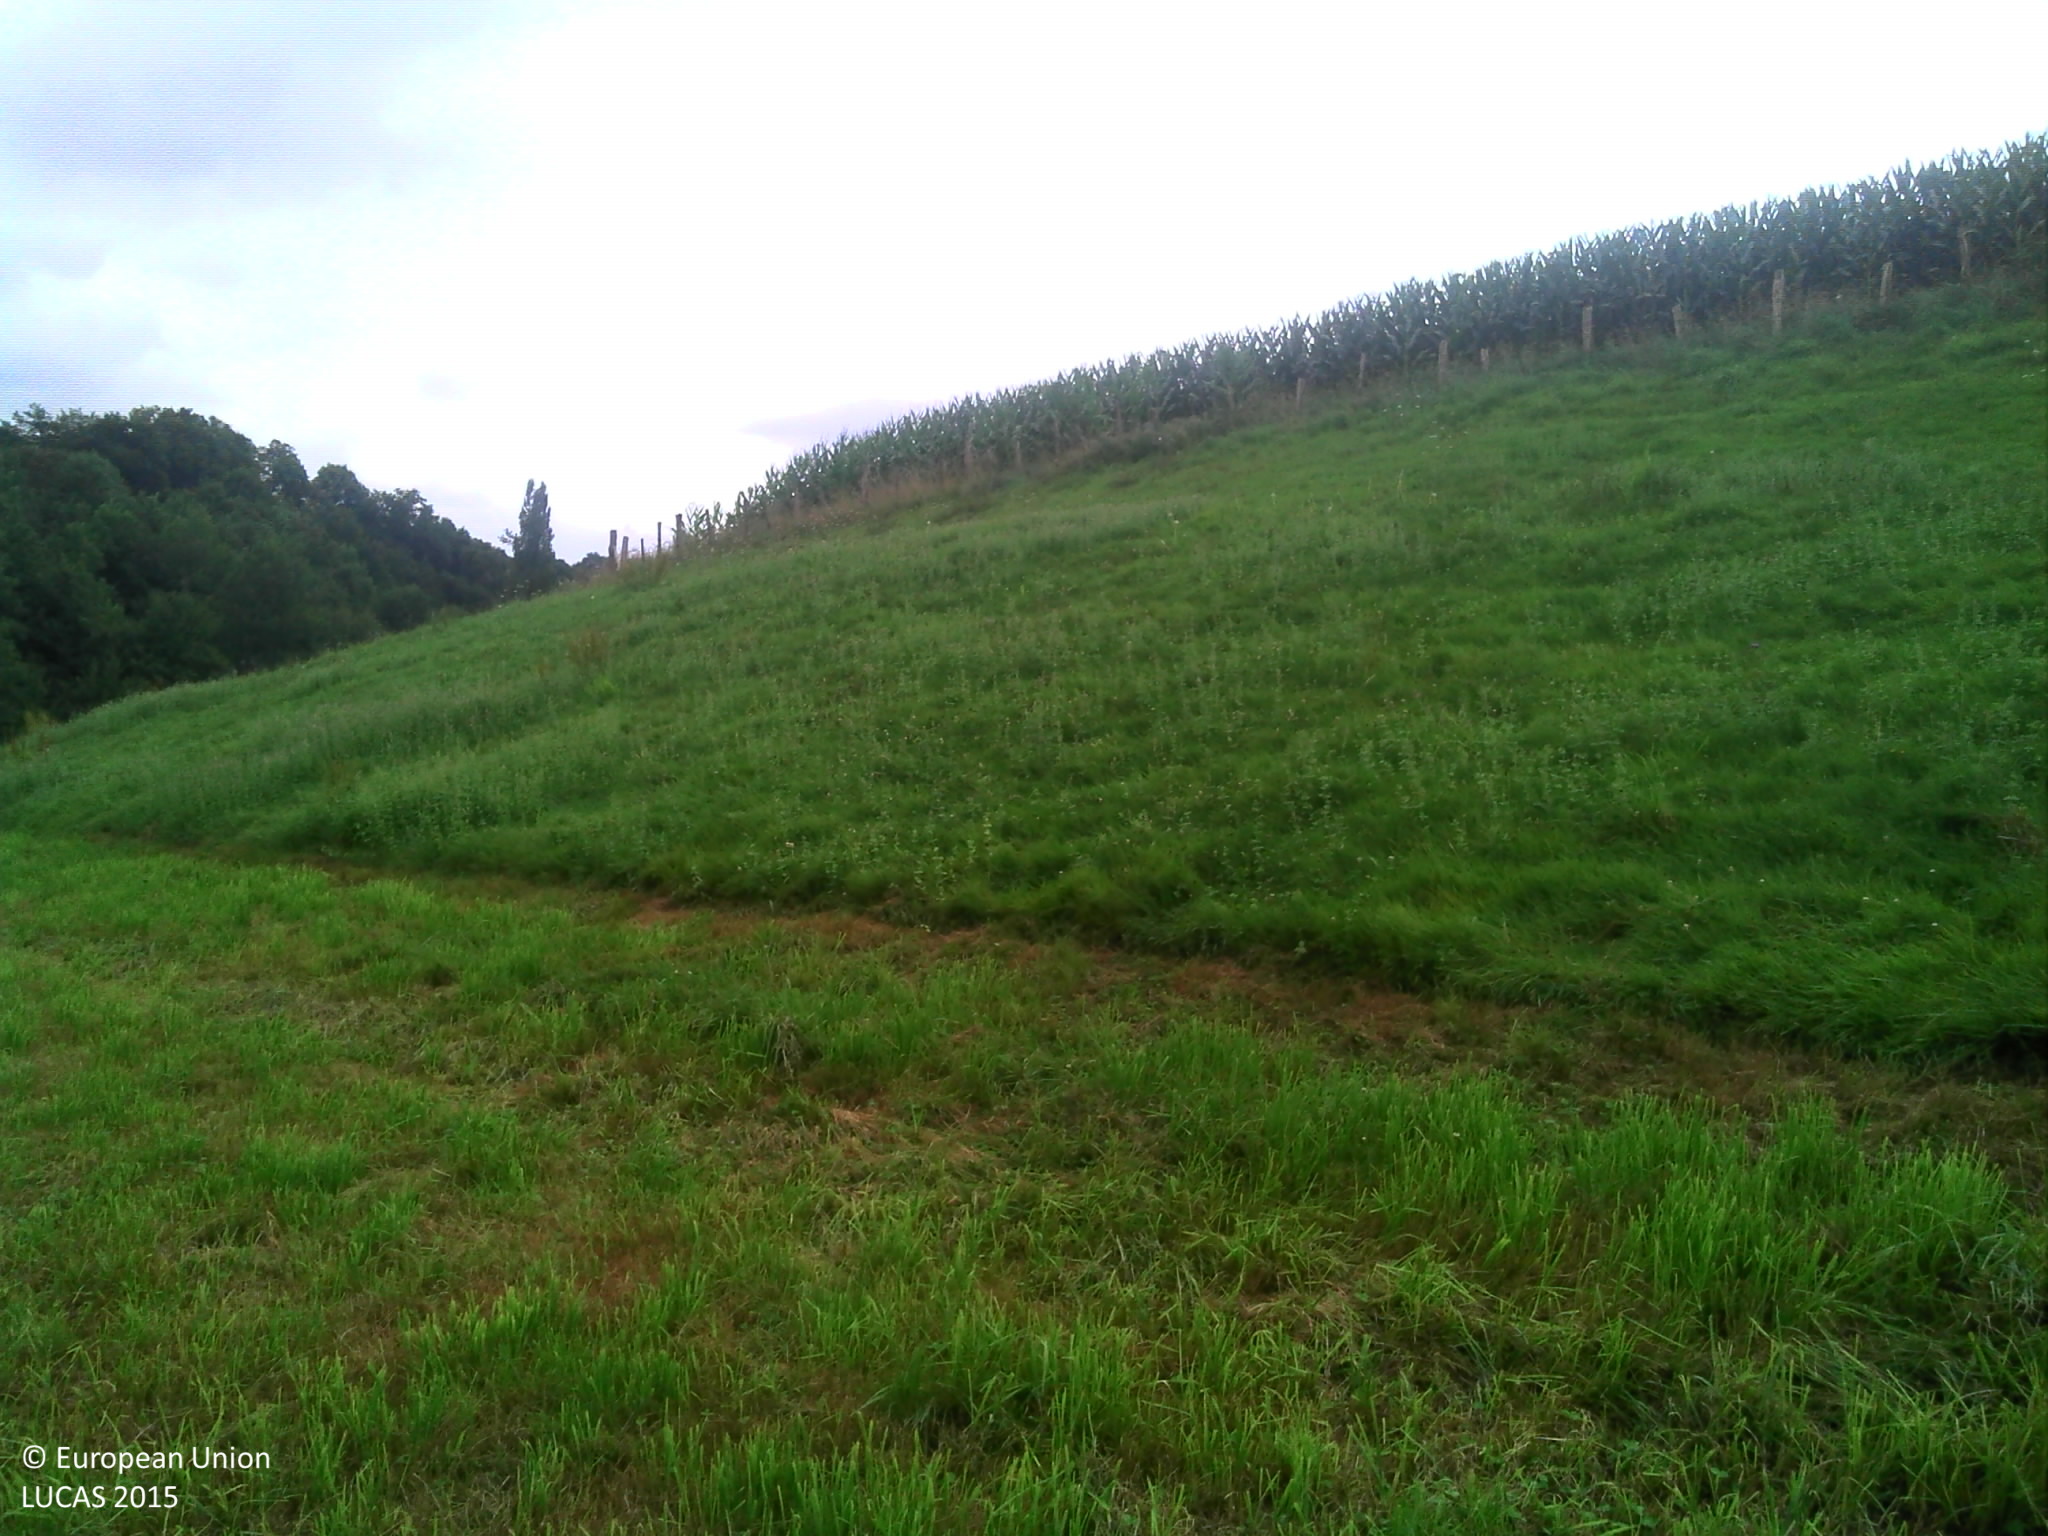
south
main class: Grassland
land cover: Grassland without tree/shrub cover
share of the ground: > 75 %
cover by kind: herbaceous plants 100 %
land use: Agriculture (excluding fallow land and kitchen gardens)
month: August
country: FR
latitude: 43.2347
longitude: -1.1819
